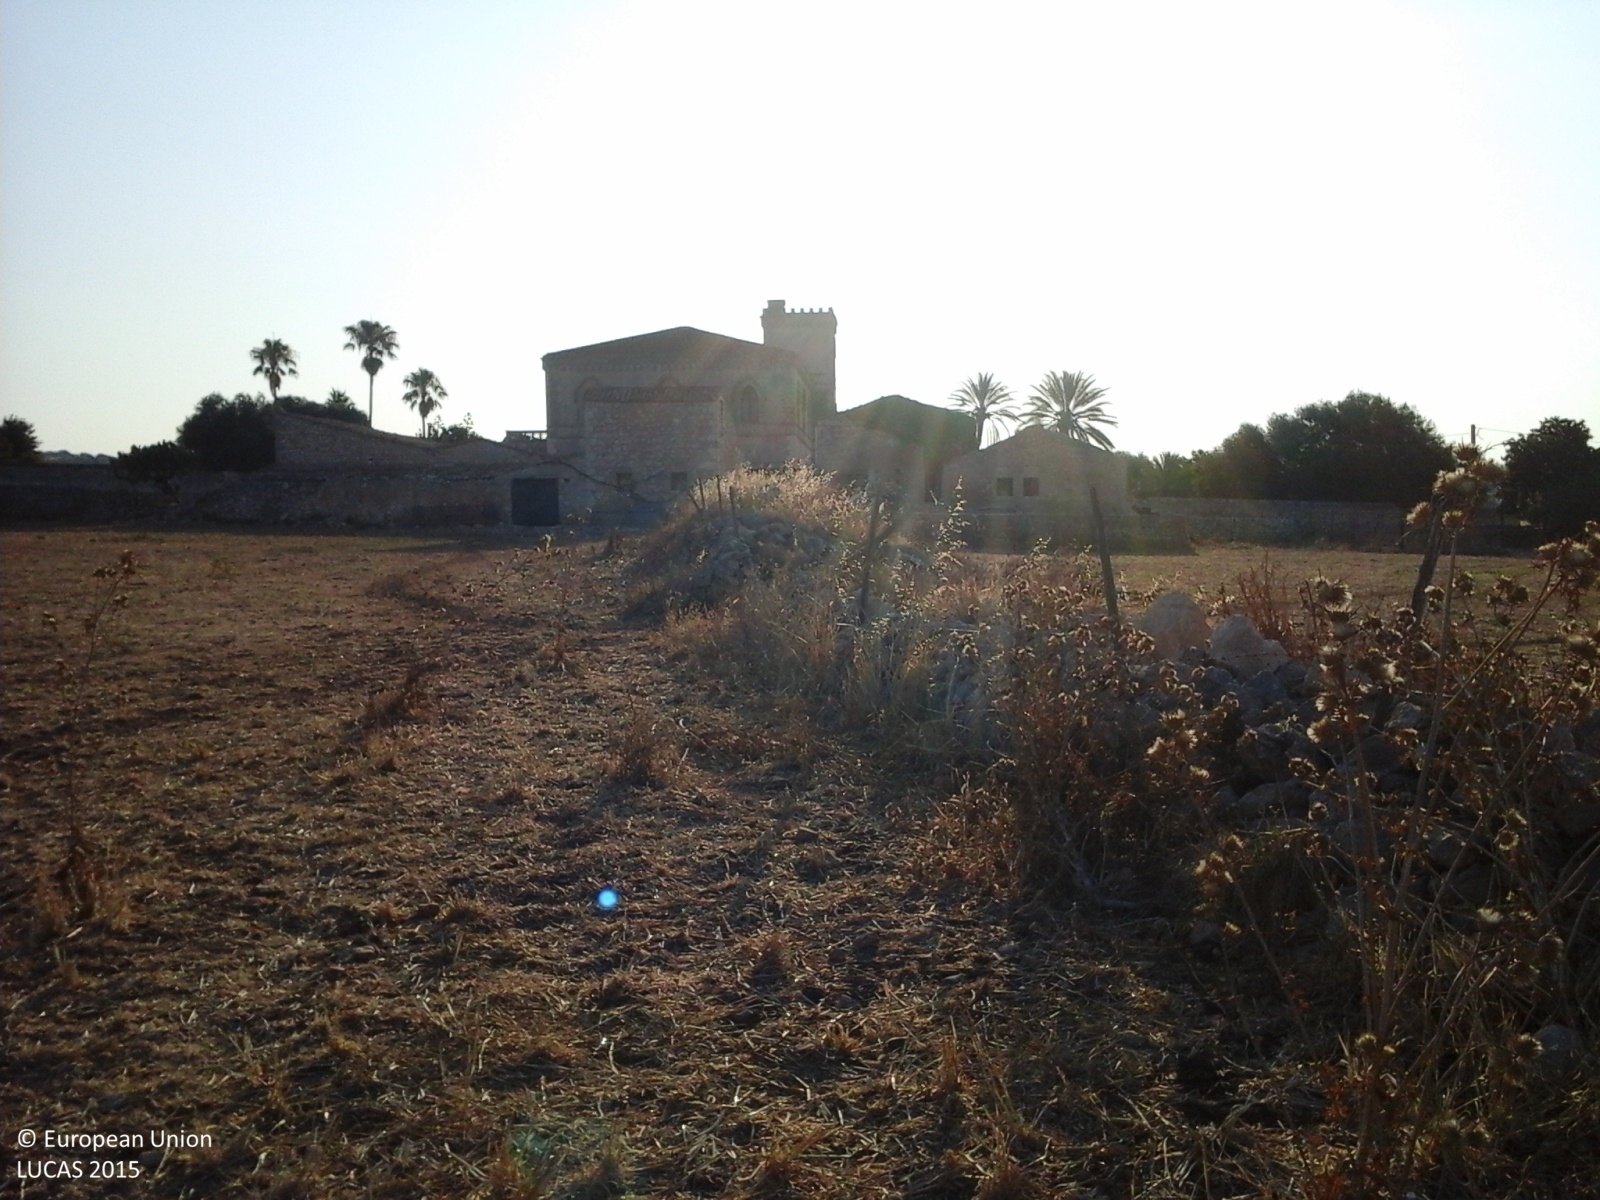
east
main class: Cropland
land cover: Mixed cereals for fodder
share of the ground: > 75 %
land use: Agriculture (excluding fallow land and kitchen gardens)
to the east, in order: Mixed cereals for fodder; Grass margins; Dry stone walls; Grass margins; Mixed cereals for fodder; Grass margins; Artificial constructions in urban areas; Grass margins; Durum wheat; Other fruit trees and berries; Durum wheat; Grass margins; Dry stone walls; Grass margins; Durum wheat
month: July
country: IT
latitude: 36.8747
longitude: 14.5518
